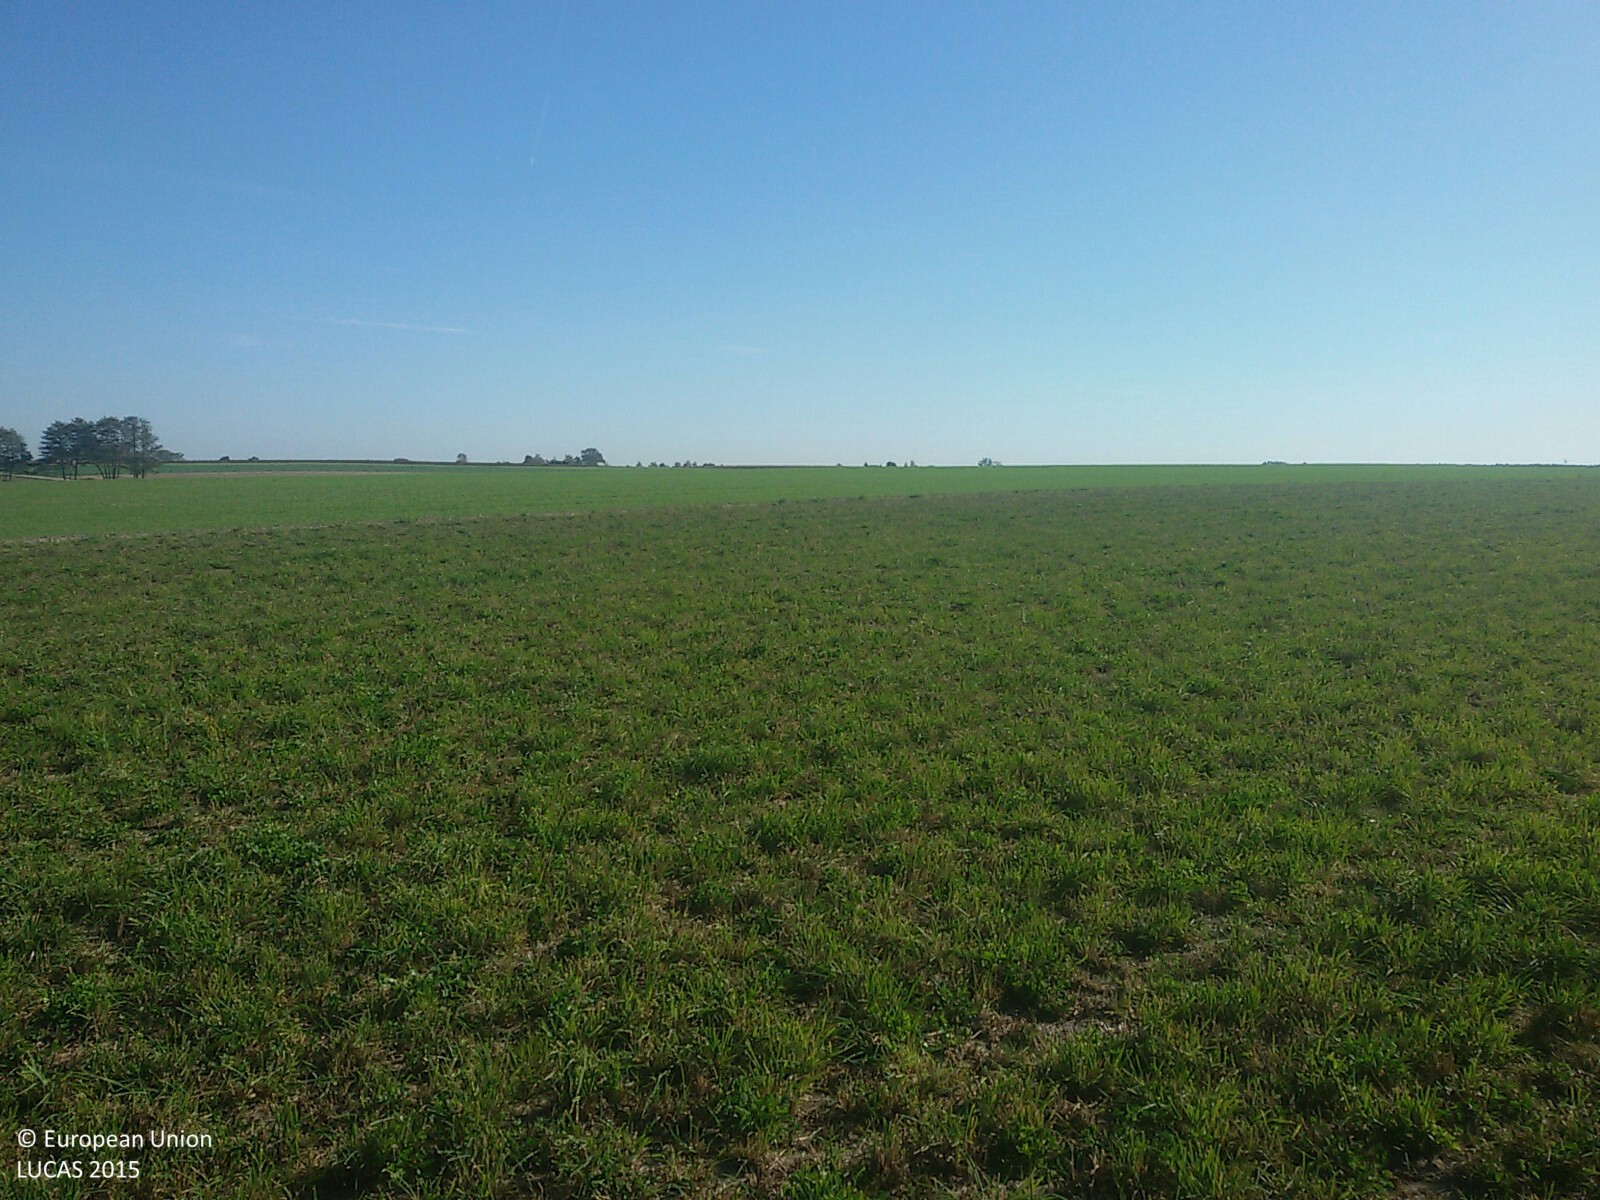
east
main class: Grassland
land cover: Grassland without tree/shrub cover
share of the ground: > 75 %
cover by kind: herbaceous plants 100 %
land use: Agriculture (excluding fallow land and kitchen gardens)
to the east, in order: Grassland without tree/shrub cover; Triticale; Tracks; Grass margins; Common wheat
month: October
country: PL
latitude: 53.2137
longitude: 19.2038
